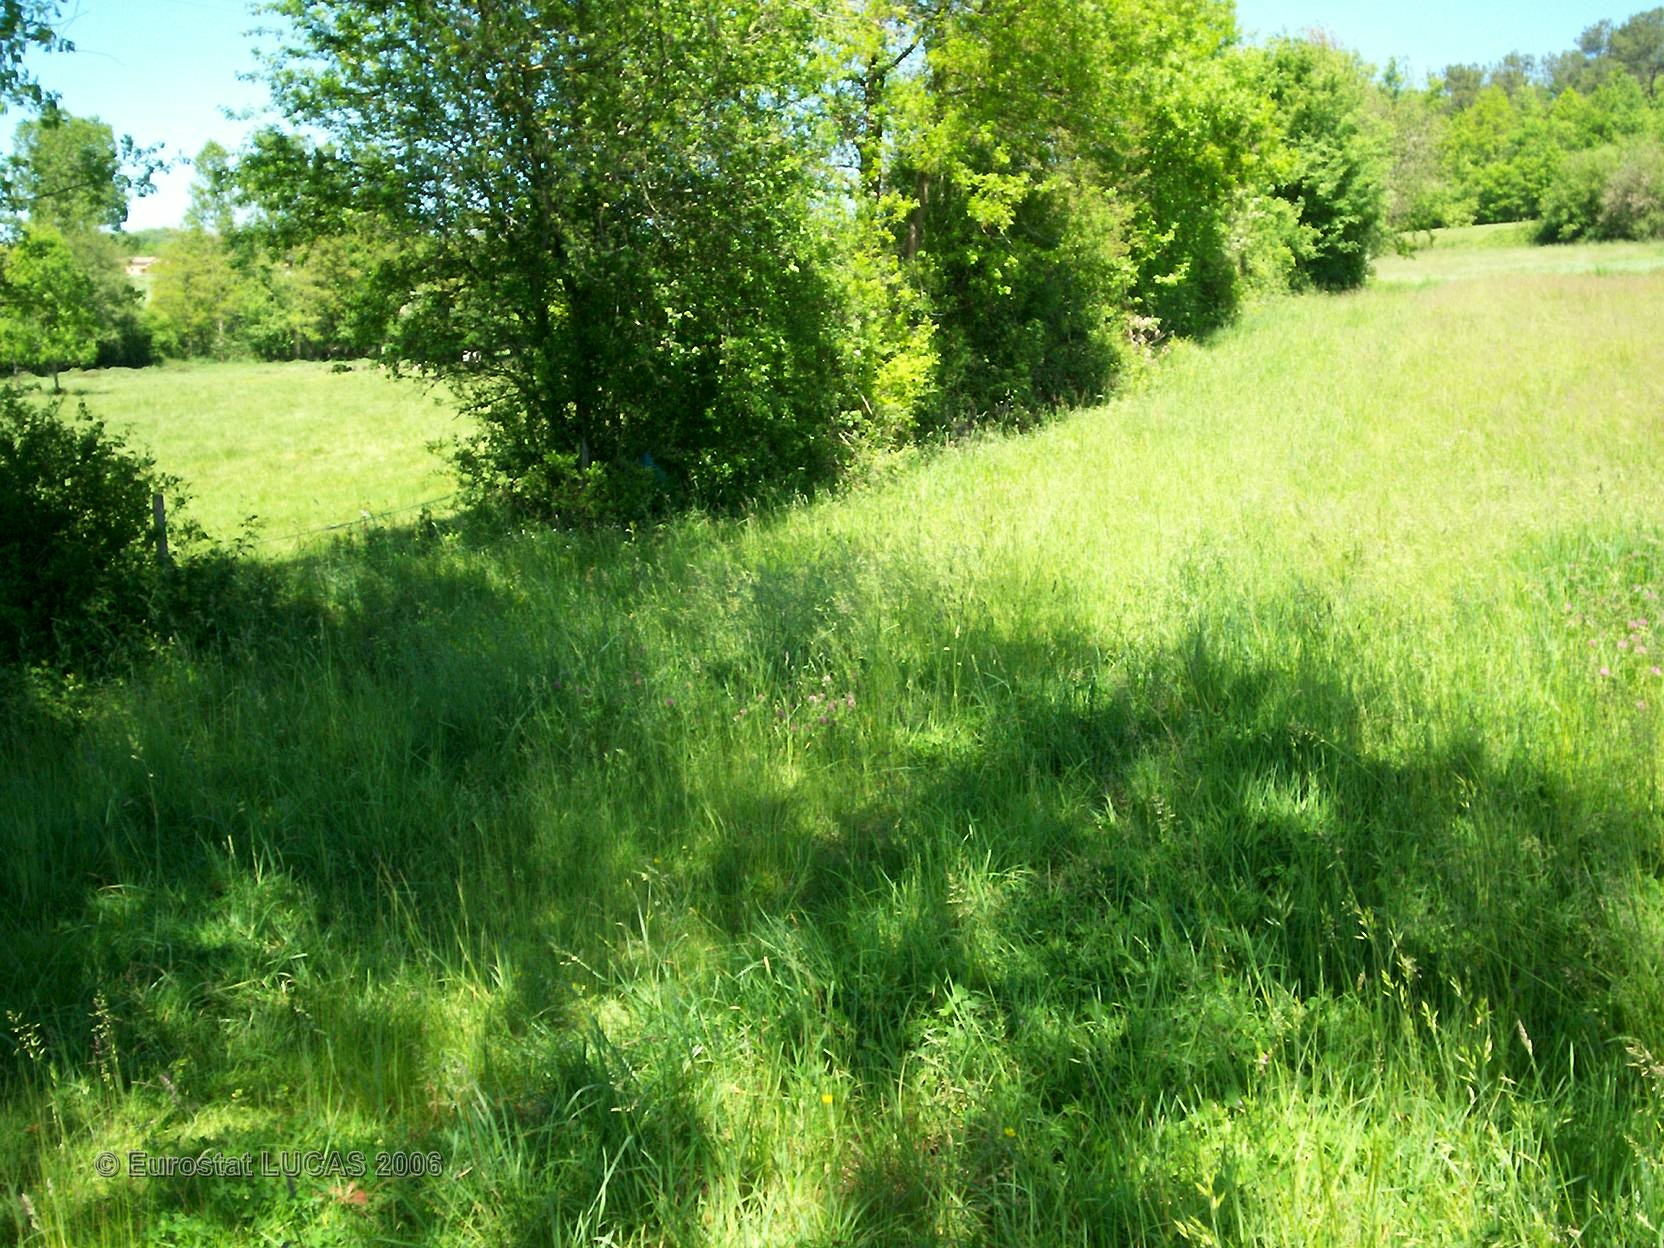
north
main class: Grassland
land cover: Grassland without tree/shrub cover
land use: Agriculture (excluding fallow land and kitchen gardens)
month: May
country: FR
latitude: 43.1865
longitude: 0.8850
